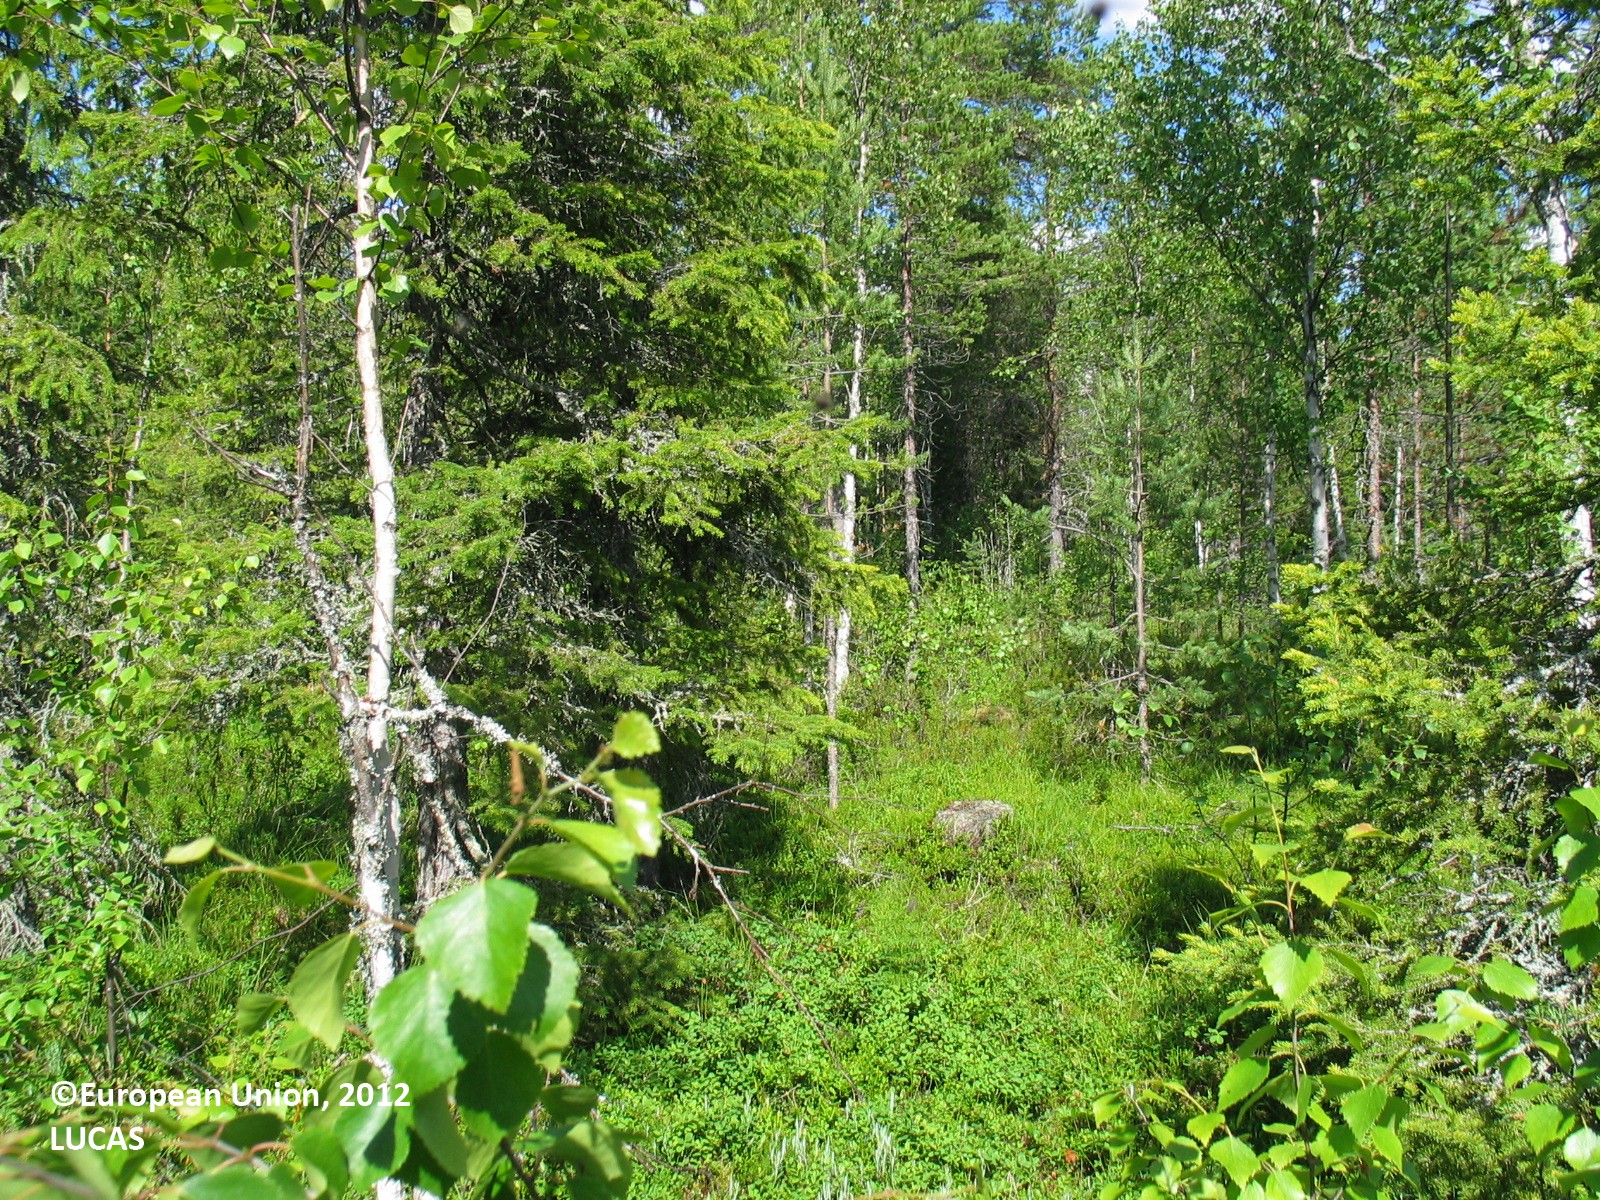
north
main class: Woodland
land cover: Other mixed woodland
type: mire and swamp forests
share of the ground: 25 - 50 %
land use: Forestry
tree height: > 5 m
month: July
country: FI
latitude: 65.9565
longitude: 24.9513
